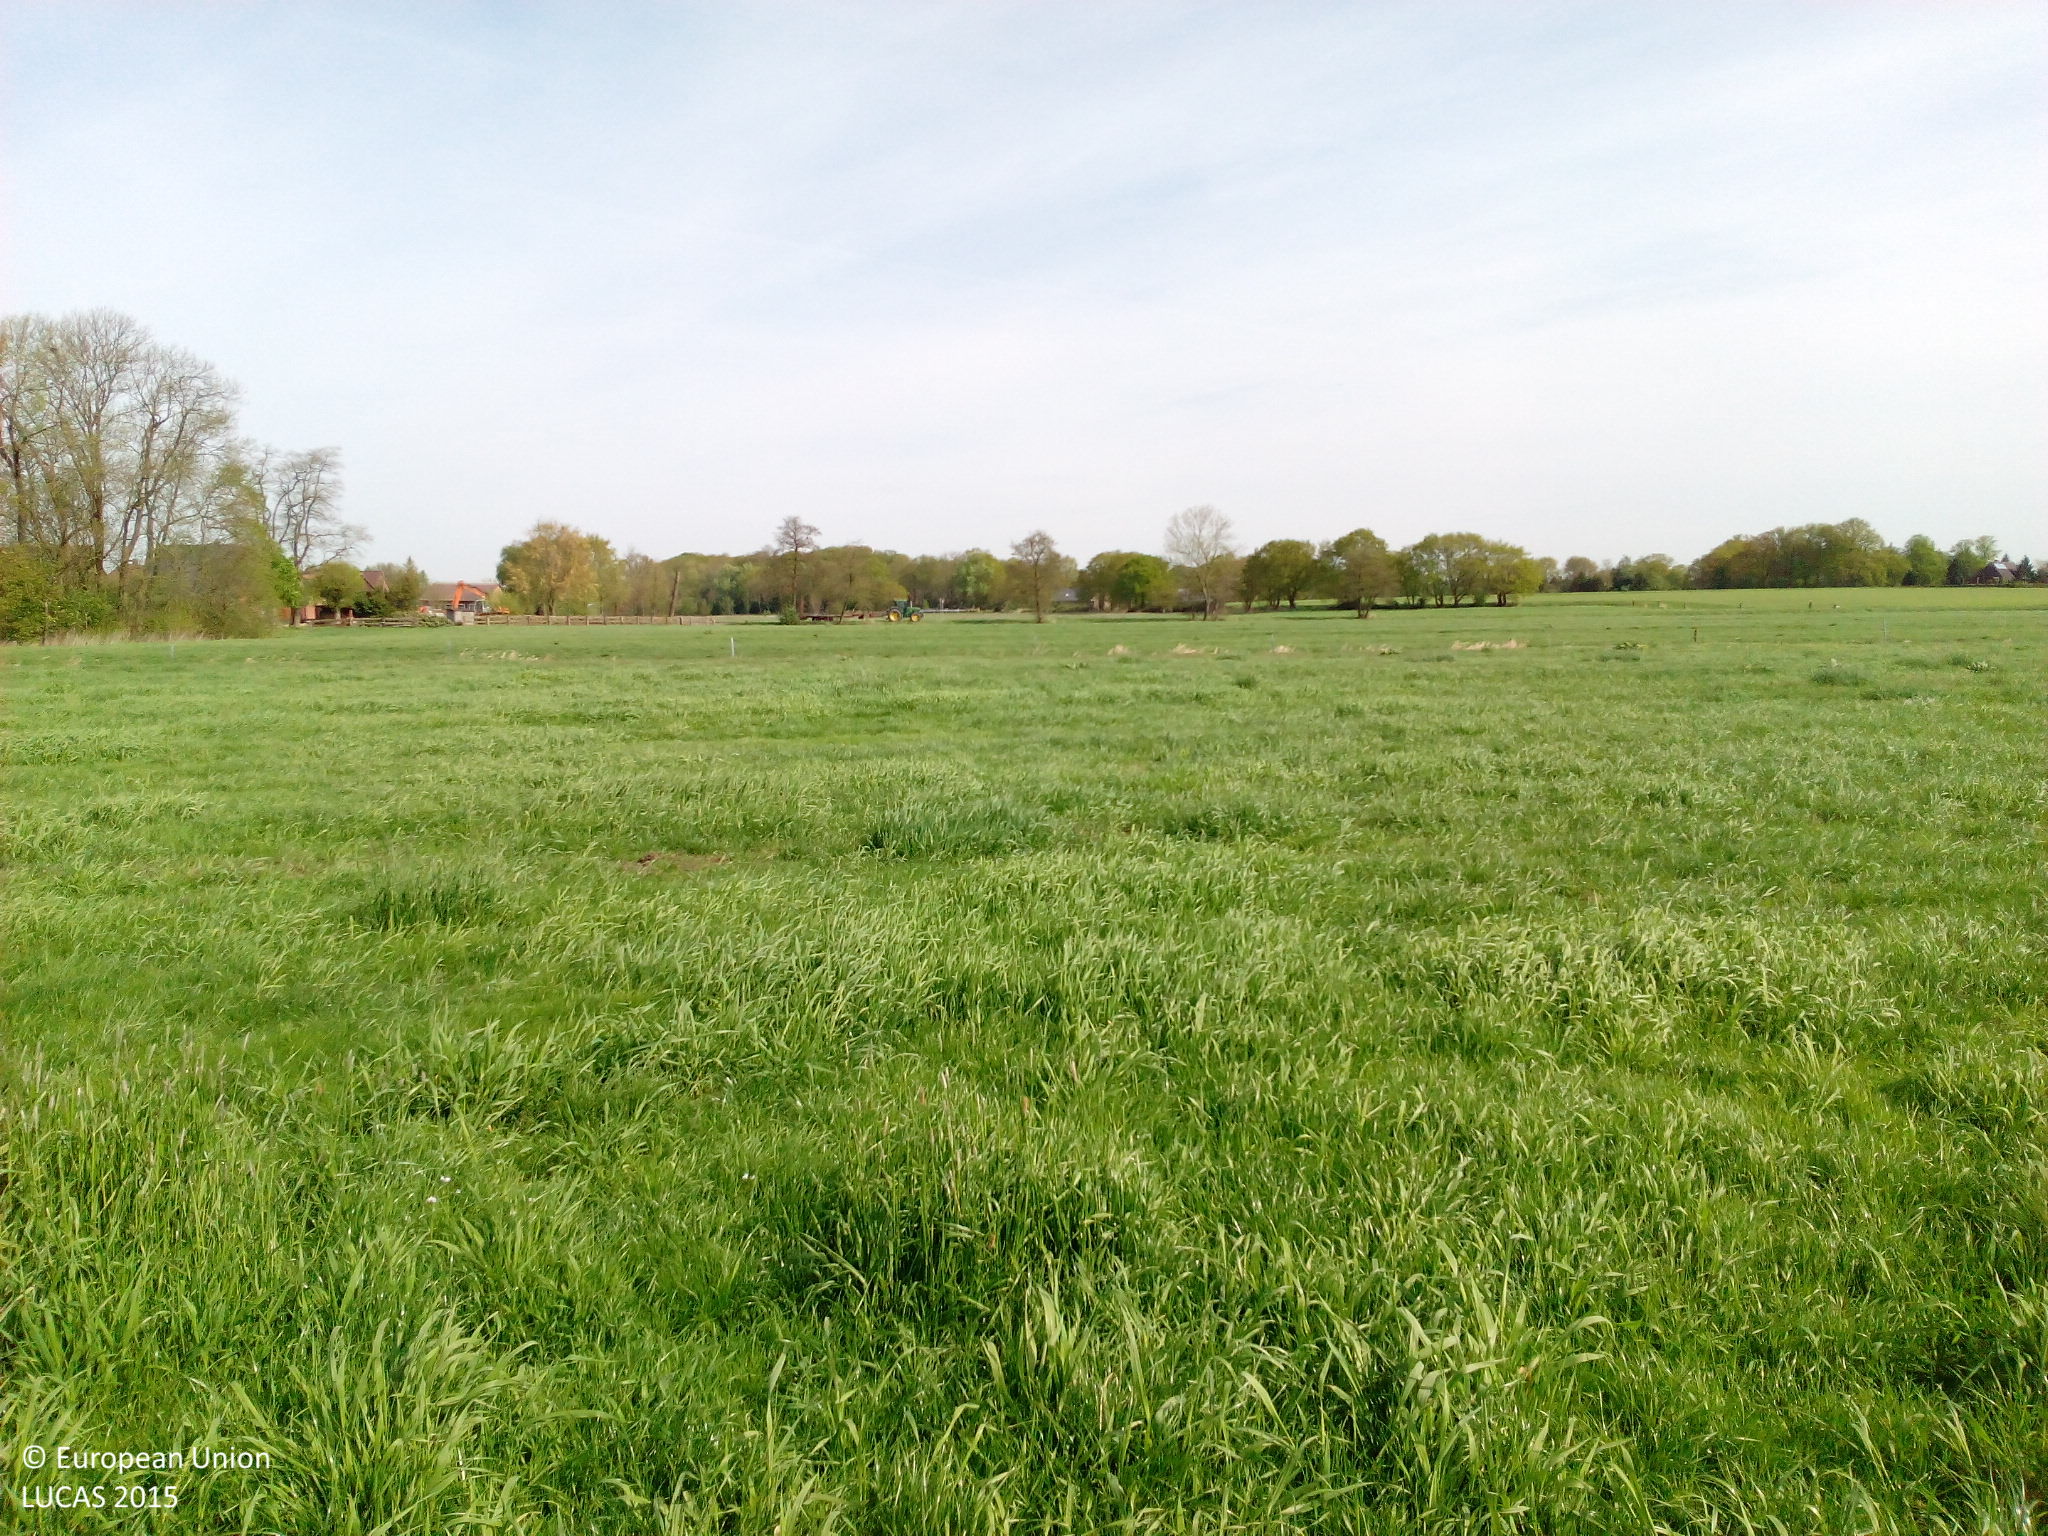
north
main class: Grassland
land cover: Grassland without tree/shrub cover
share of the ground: > 75 %
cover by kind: herbaceous plants 100 %
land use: Agriculture (excluding fallow land and kitchen gardens)
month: May
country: DE
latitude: 53.4115
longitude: 8.5714
